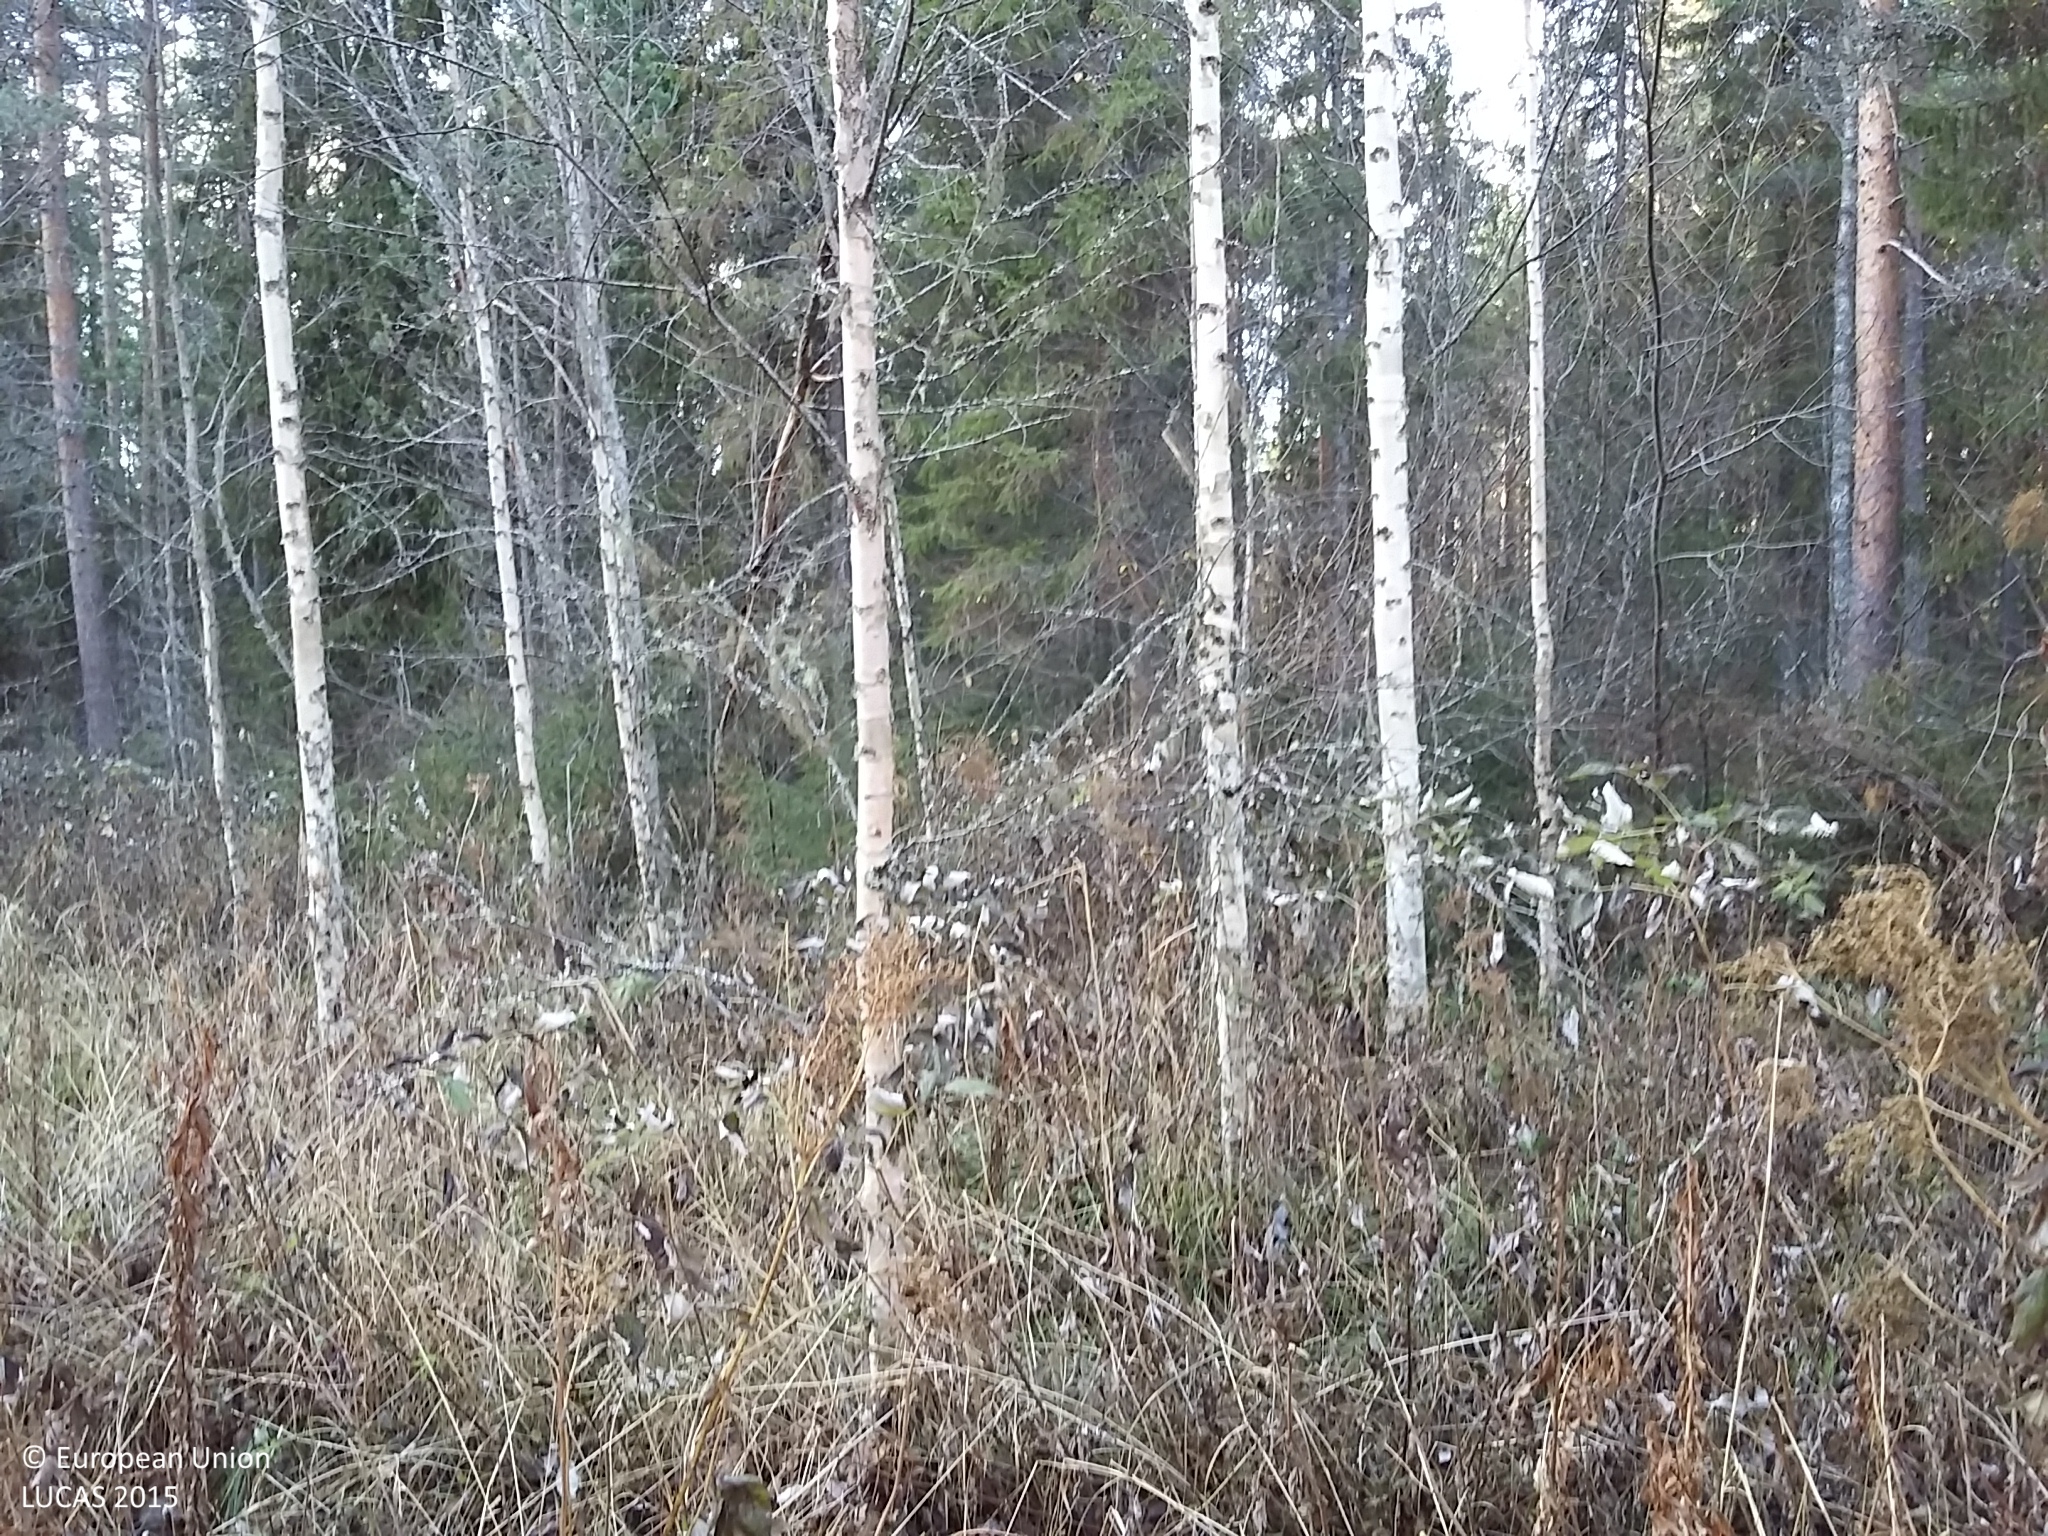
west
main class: Woodland
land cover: Broadleaved woodland
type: non-riverine alder, birch or aspen forest
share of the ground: 50 - 75 %
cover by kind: broadleaved forest trees 70 %, shrubs 15 %, herbaceous plants 15 %
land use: Forestry
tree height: > 5 m
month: October
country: FI
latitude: 64.5498
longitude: 25.5450
